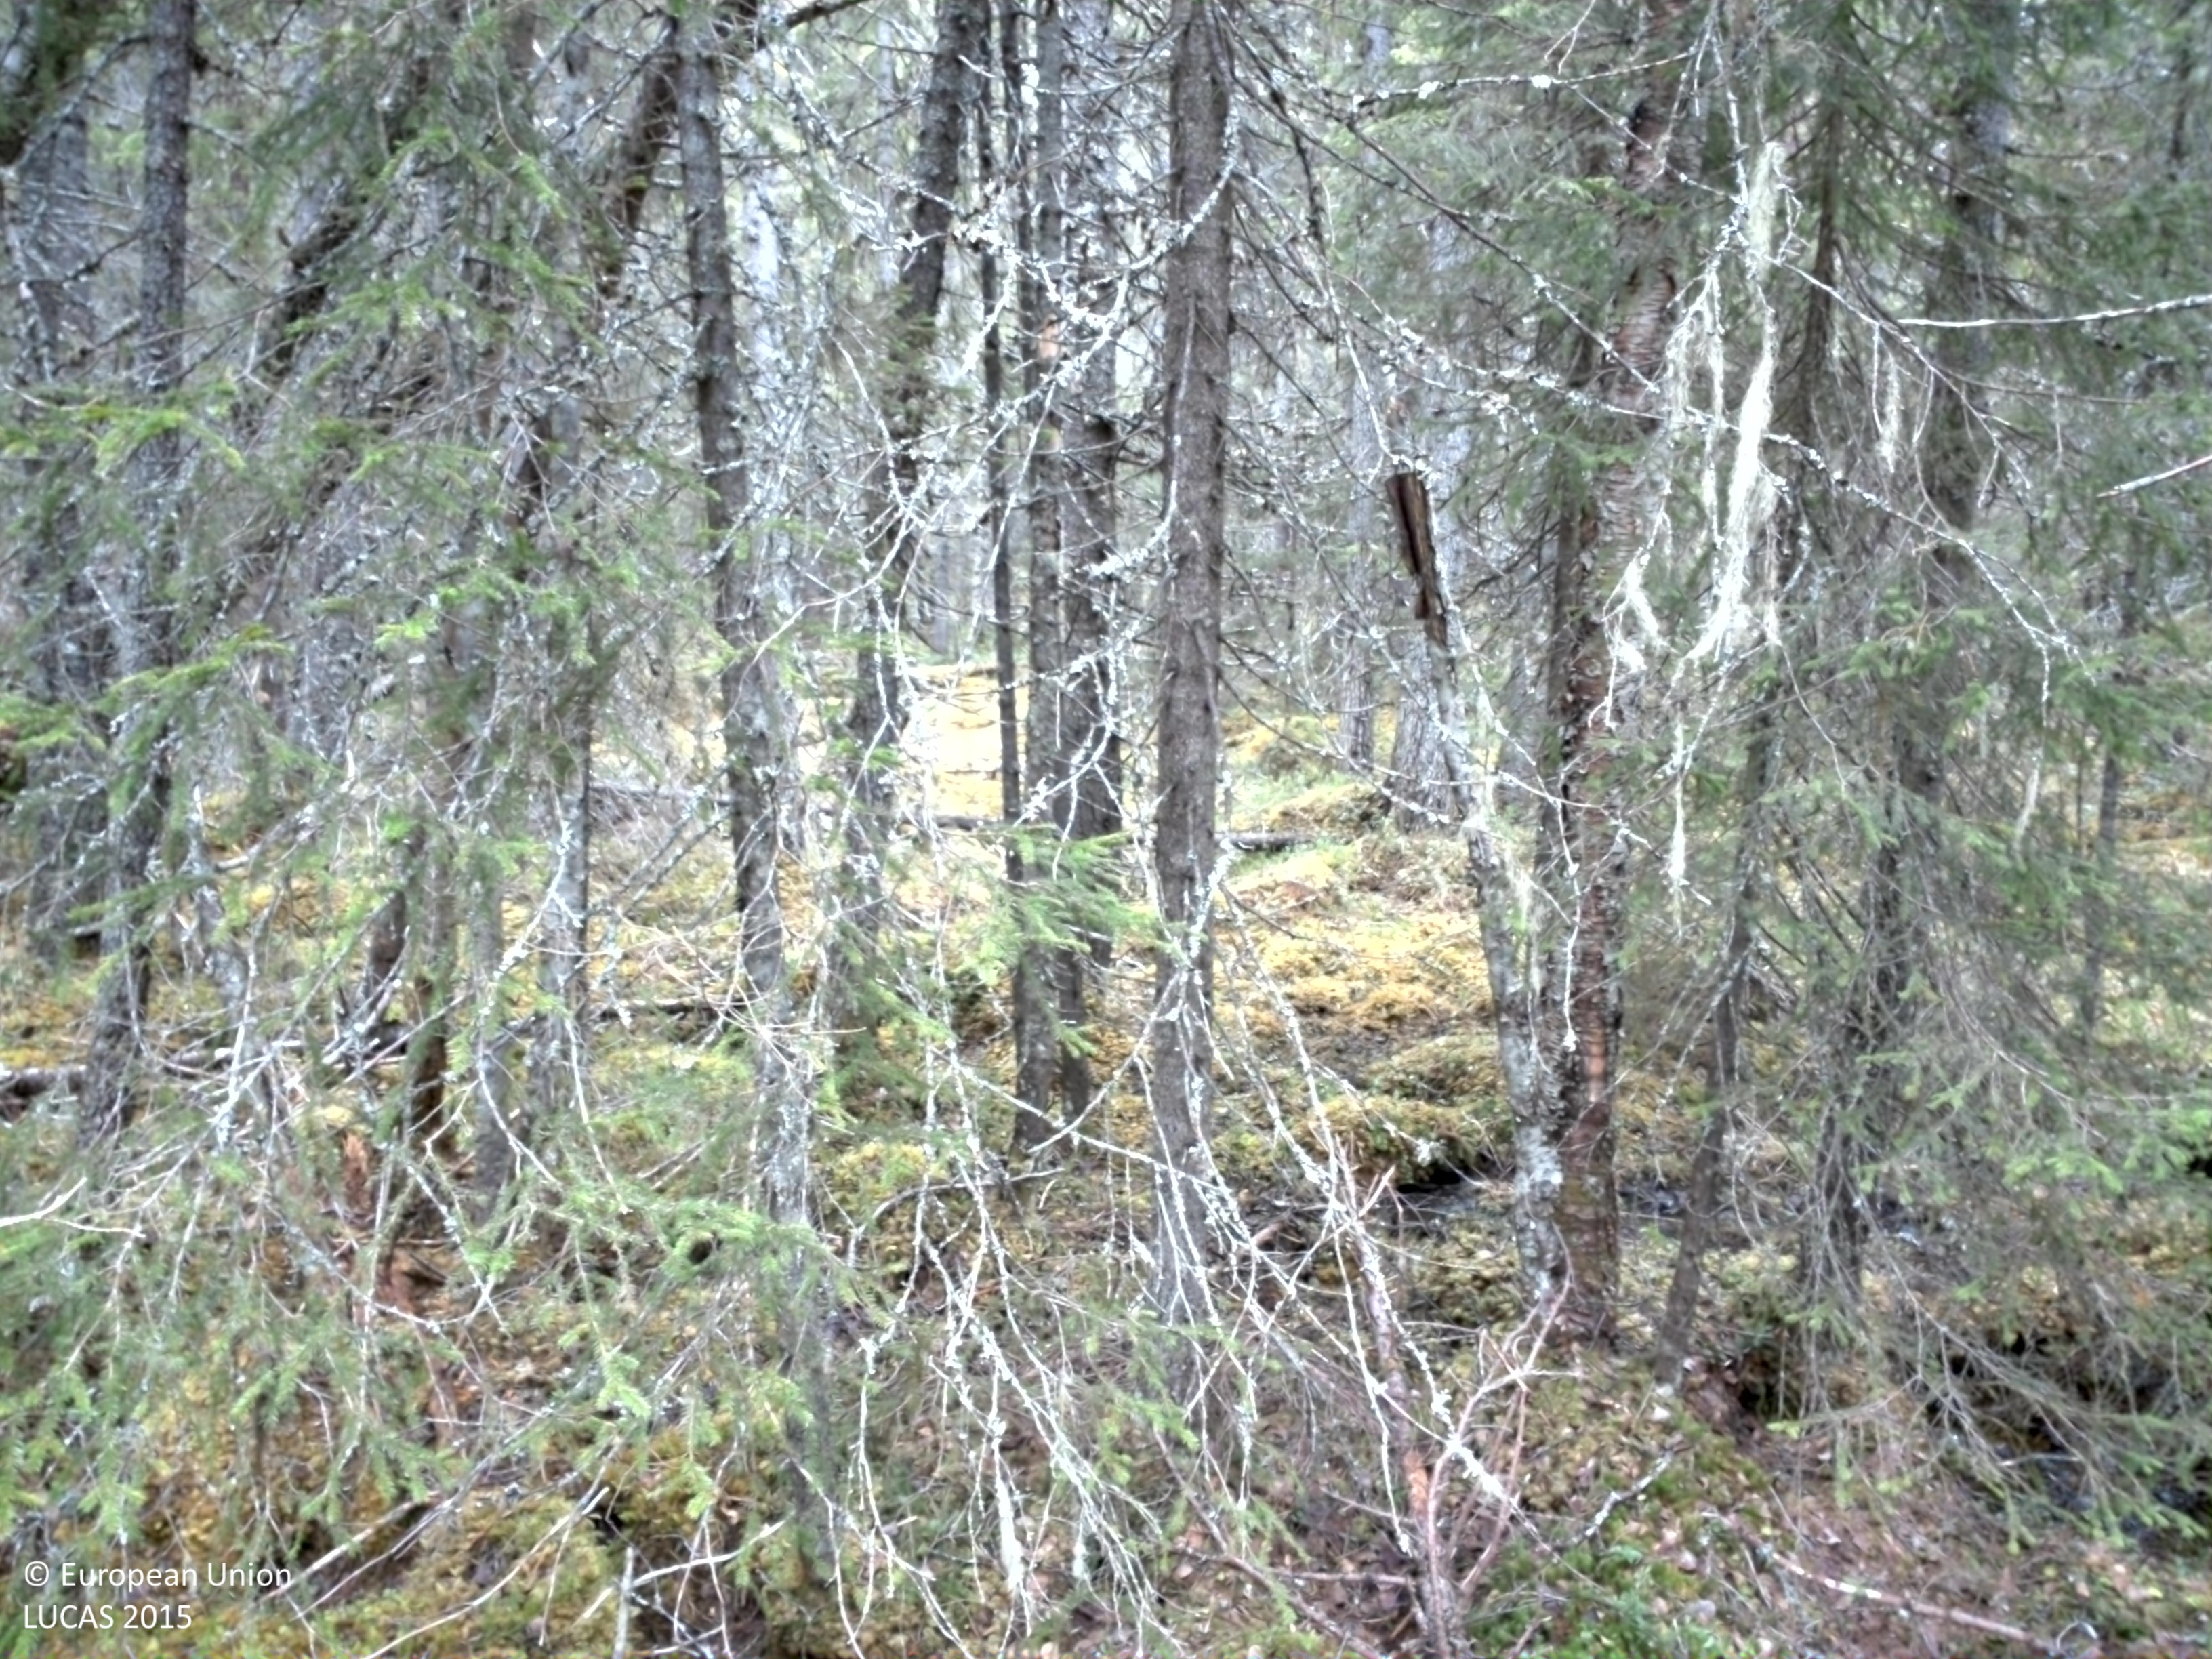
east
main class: Woodland
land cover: Spruce dominated coniferous woodland
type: boreal forest
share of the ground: > 75 %
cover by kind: coniferous forest trees 80 %, lichens and mosses 15 %, broadleaved forest trees 5 %
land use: Forestry
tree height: > 5 m
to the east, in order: Spruce dominated coniferous woodland
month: May
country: SE
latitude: 63.3598
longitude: 13.7591
